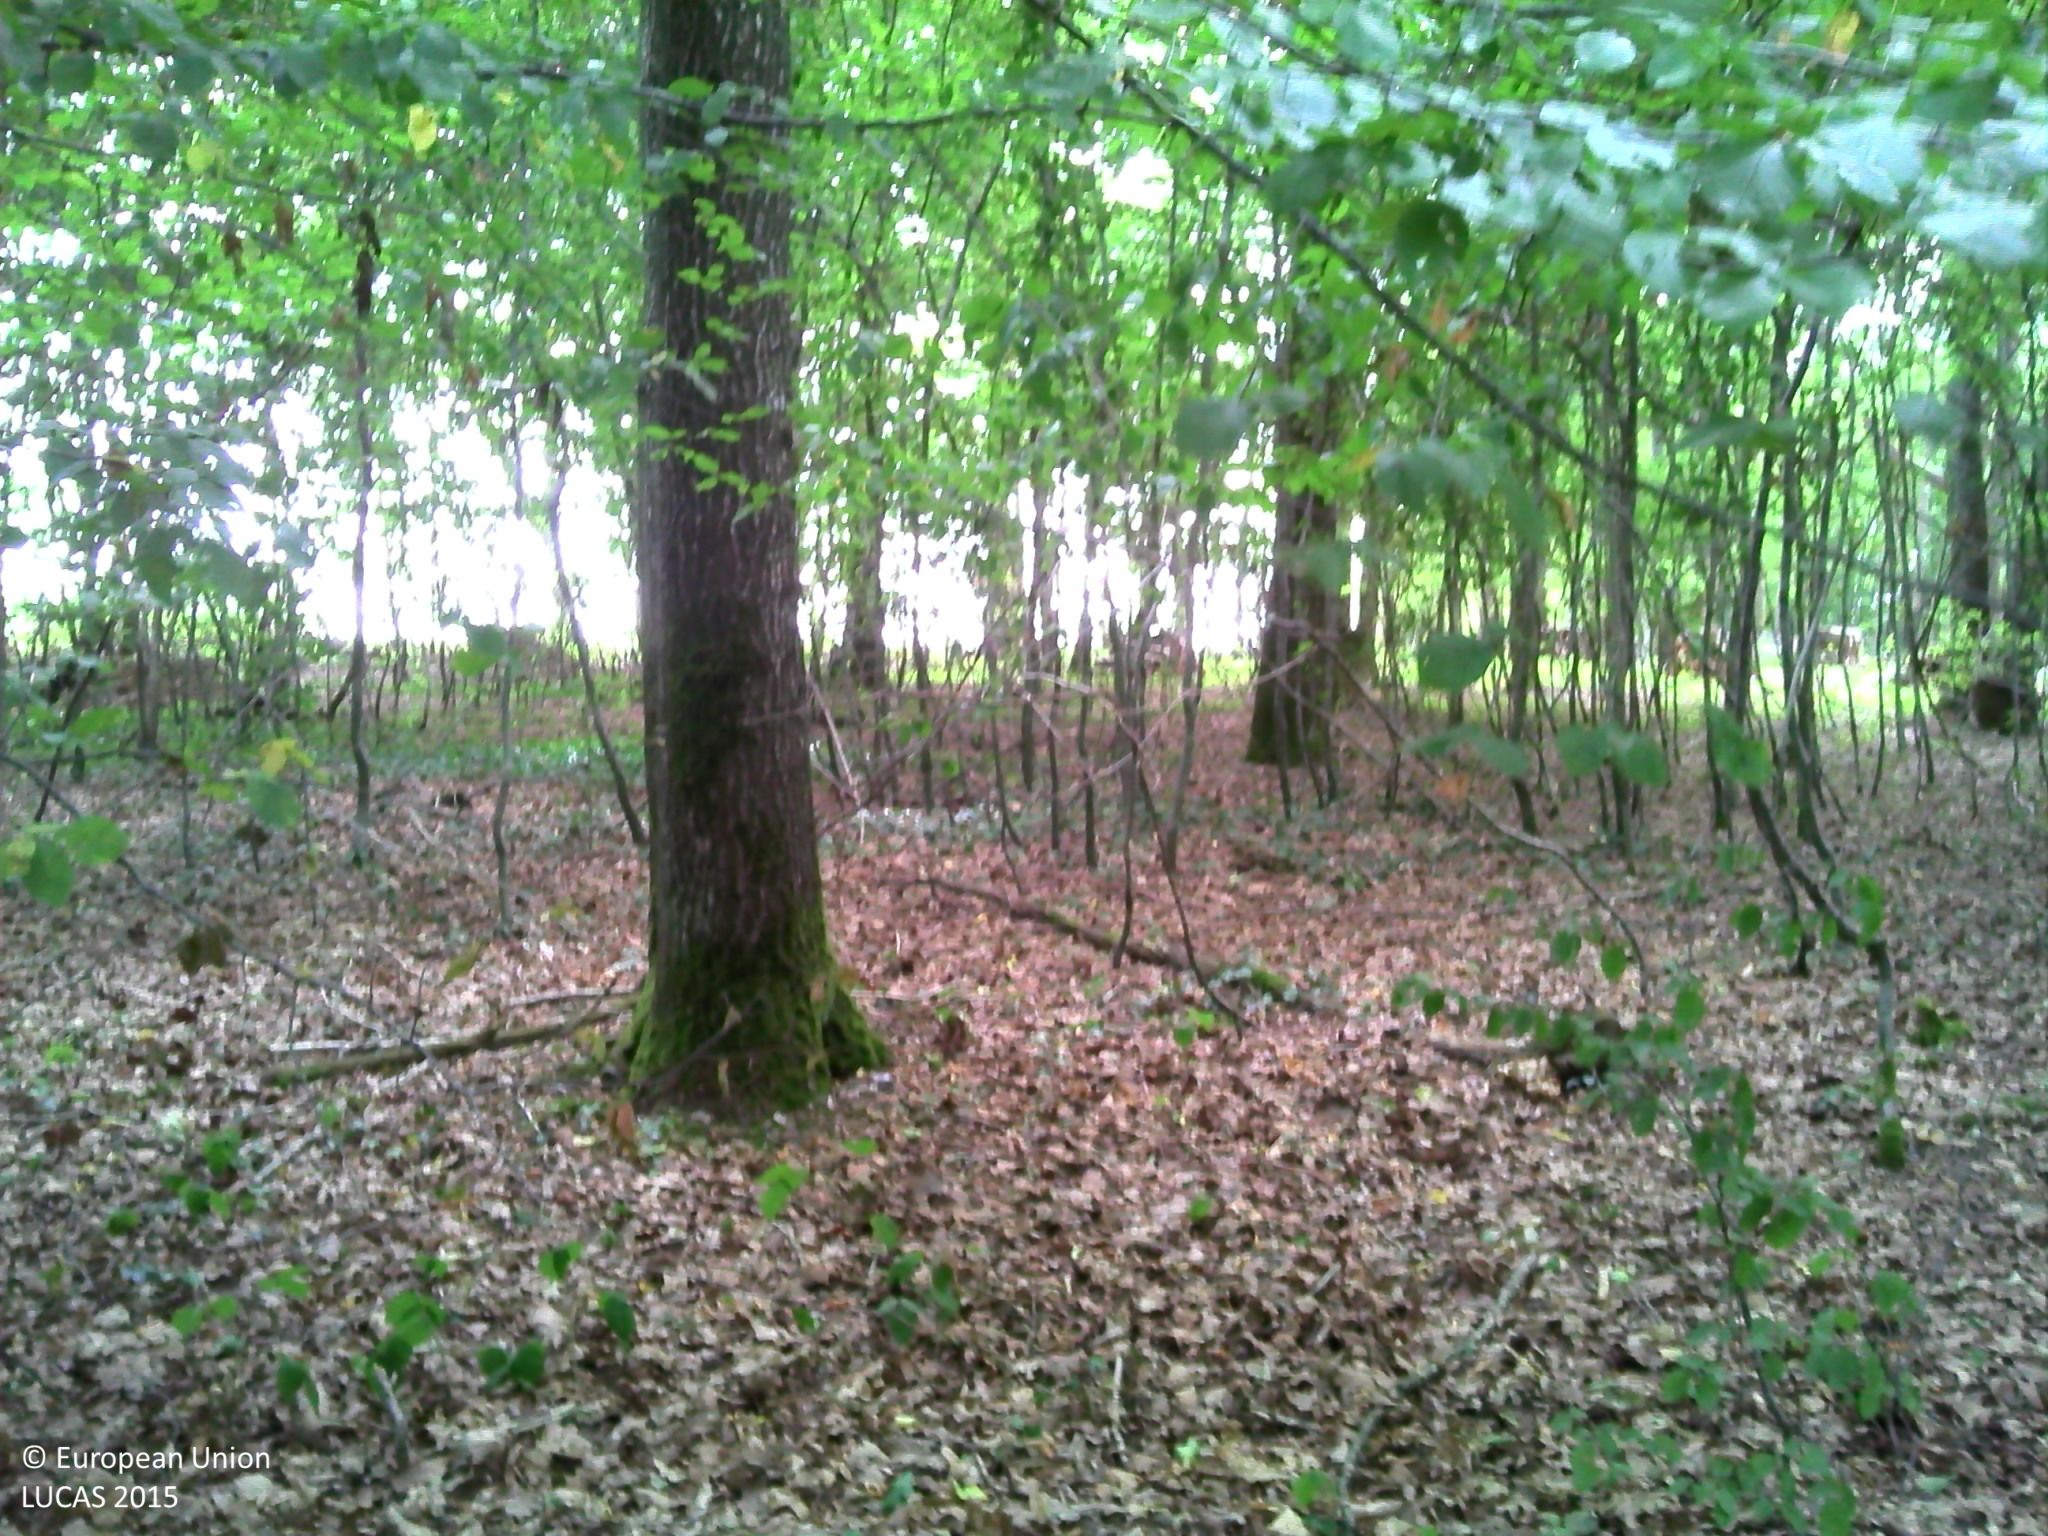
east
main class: Woodland
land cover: Broadleaved woodland
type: mesophytic deciduous forest
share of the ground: > 75 %
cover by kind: broadleaved forest trees 90 %, herbaceous plants 5 %, lichens and mosses 5 %
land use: Forestry
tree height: > 5 m
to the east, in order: Broadleaved woodland; Grassland without tree/shrub cover; Common wheat; Electric lines; Common wheat
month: July
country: FR
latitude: 47.9350
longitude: 3.0998
